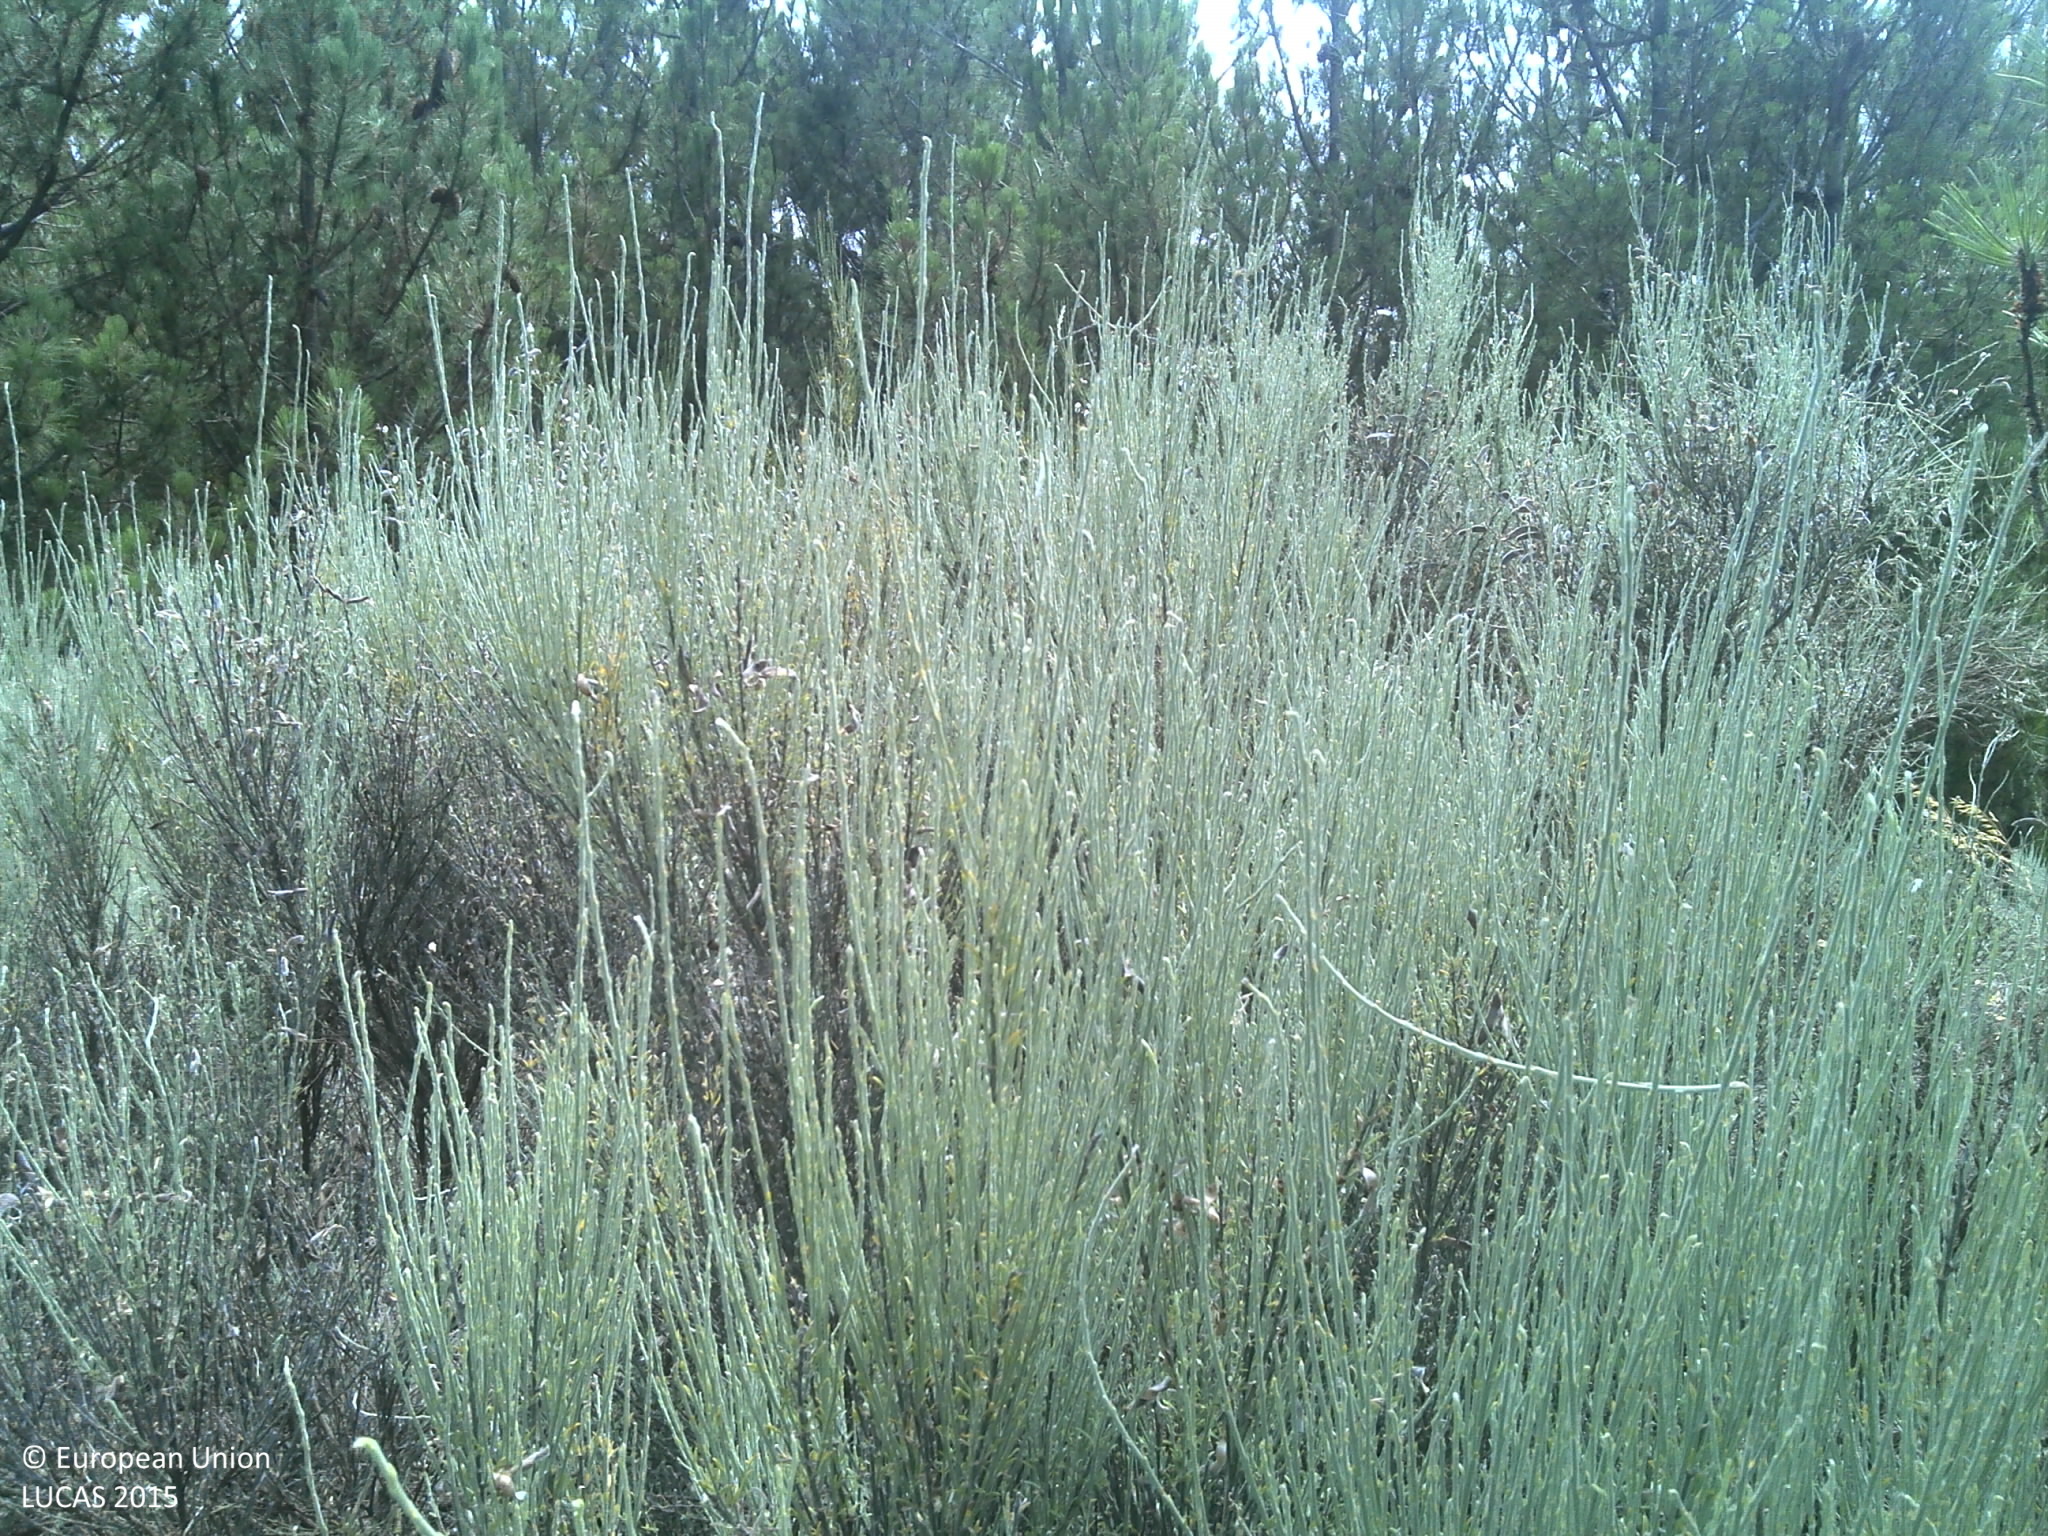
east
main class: Woodland
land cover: Pine dominated coniferous woodland
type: coniferous forest of the mediterranean region
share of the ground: 50 - 75 %
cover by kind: coniferous forest trees 50 %, shrubs 50 %
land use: Forestry
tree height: > 5 m
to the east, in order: Pine dominated coniferous woodland; Shrubland with sparse tree cover; Rock outcrops; Shrubland with sparse tree cover; Shrubland without tree cover; Shrubland with sparse tree cover
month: July
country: PT
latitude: 40.9405
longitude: -7.3492
